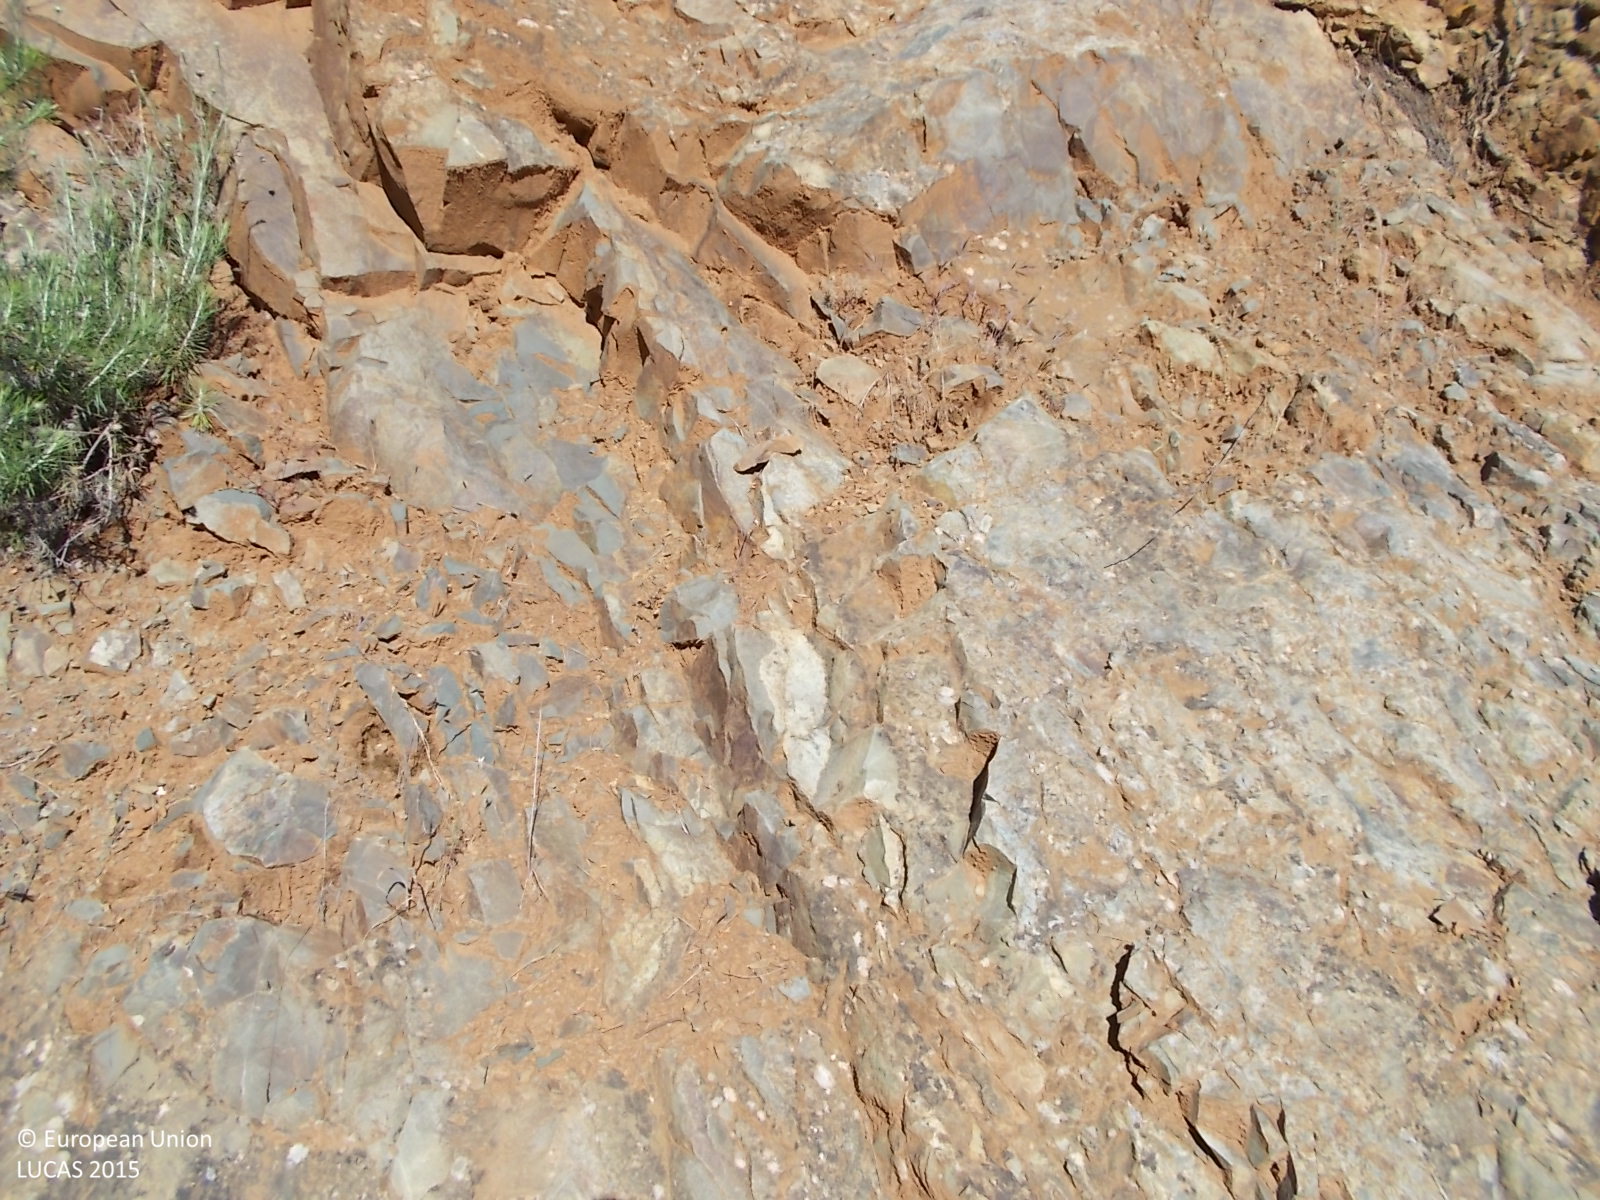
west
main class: Woodland
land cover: Pine dominated coniferous woodland
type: coniferous forest of the mediterranean region
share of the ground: > 75 %
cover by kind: coniferous forest trees 100 %
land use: Semi-natural and natural areas not in use
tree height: > 5 m
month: May
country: CY
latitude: 34.9849
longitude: 33.0602
